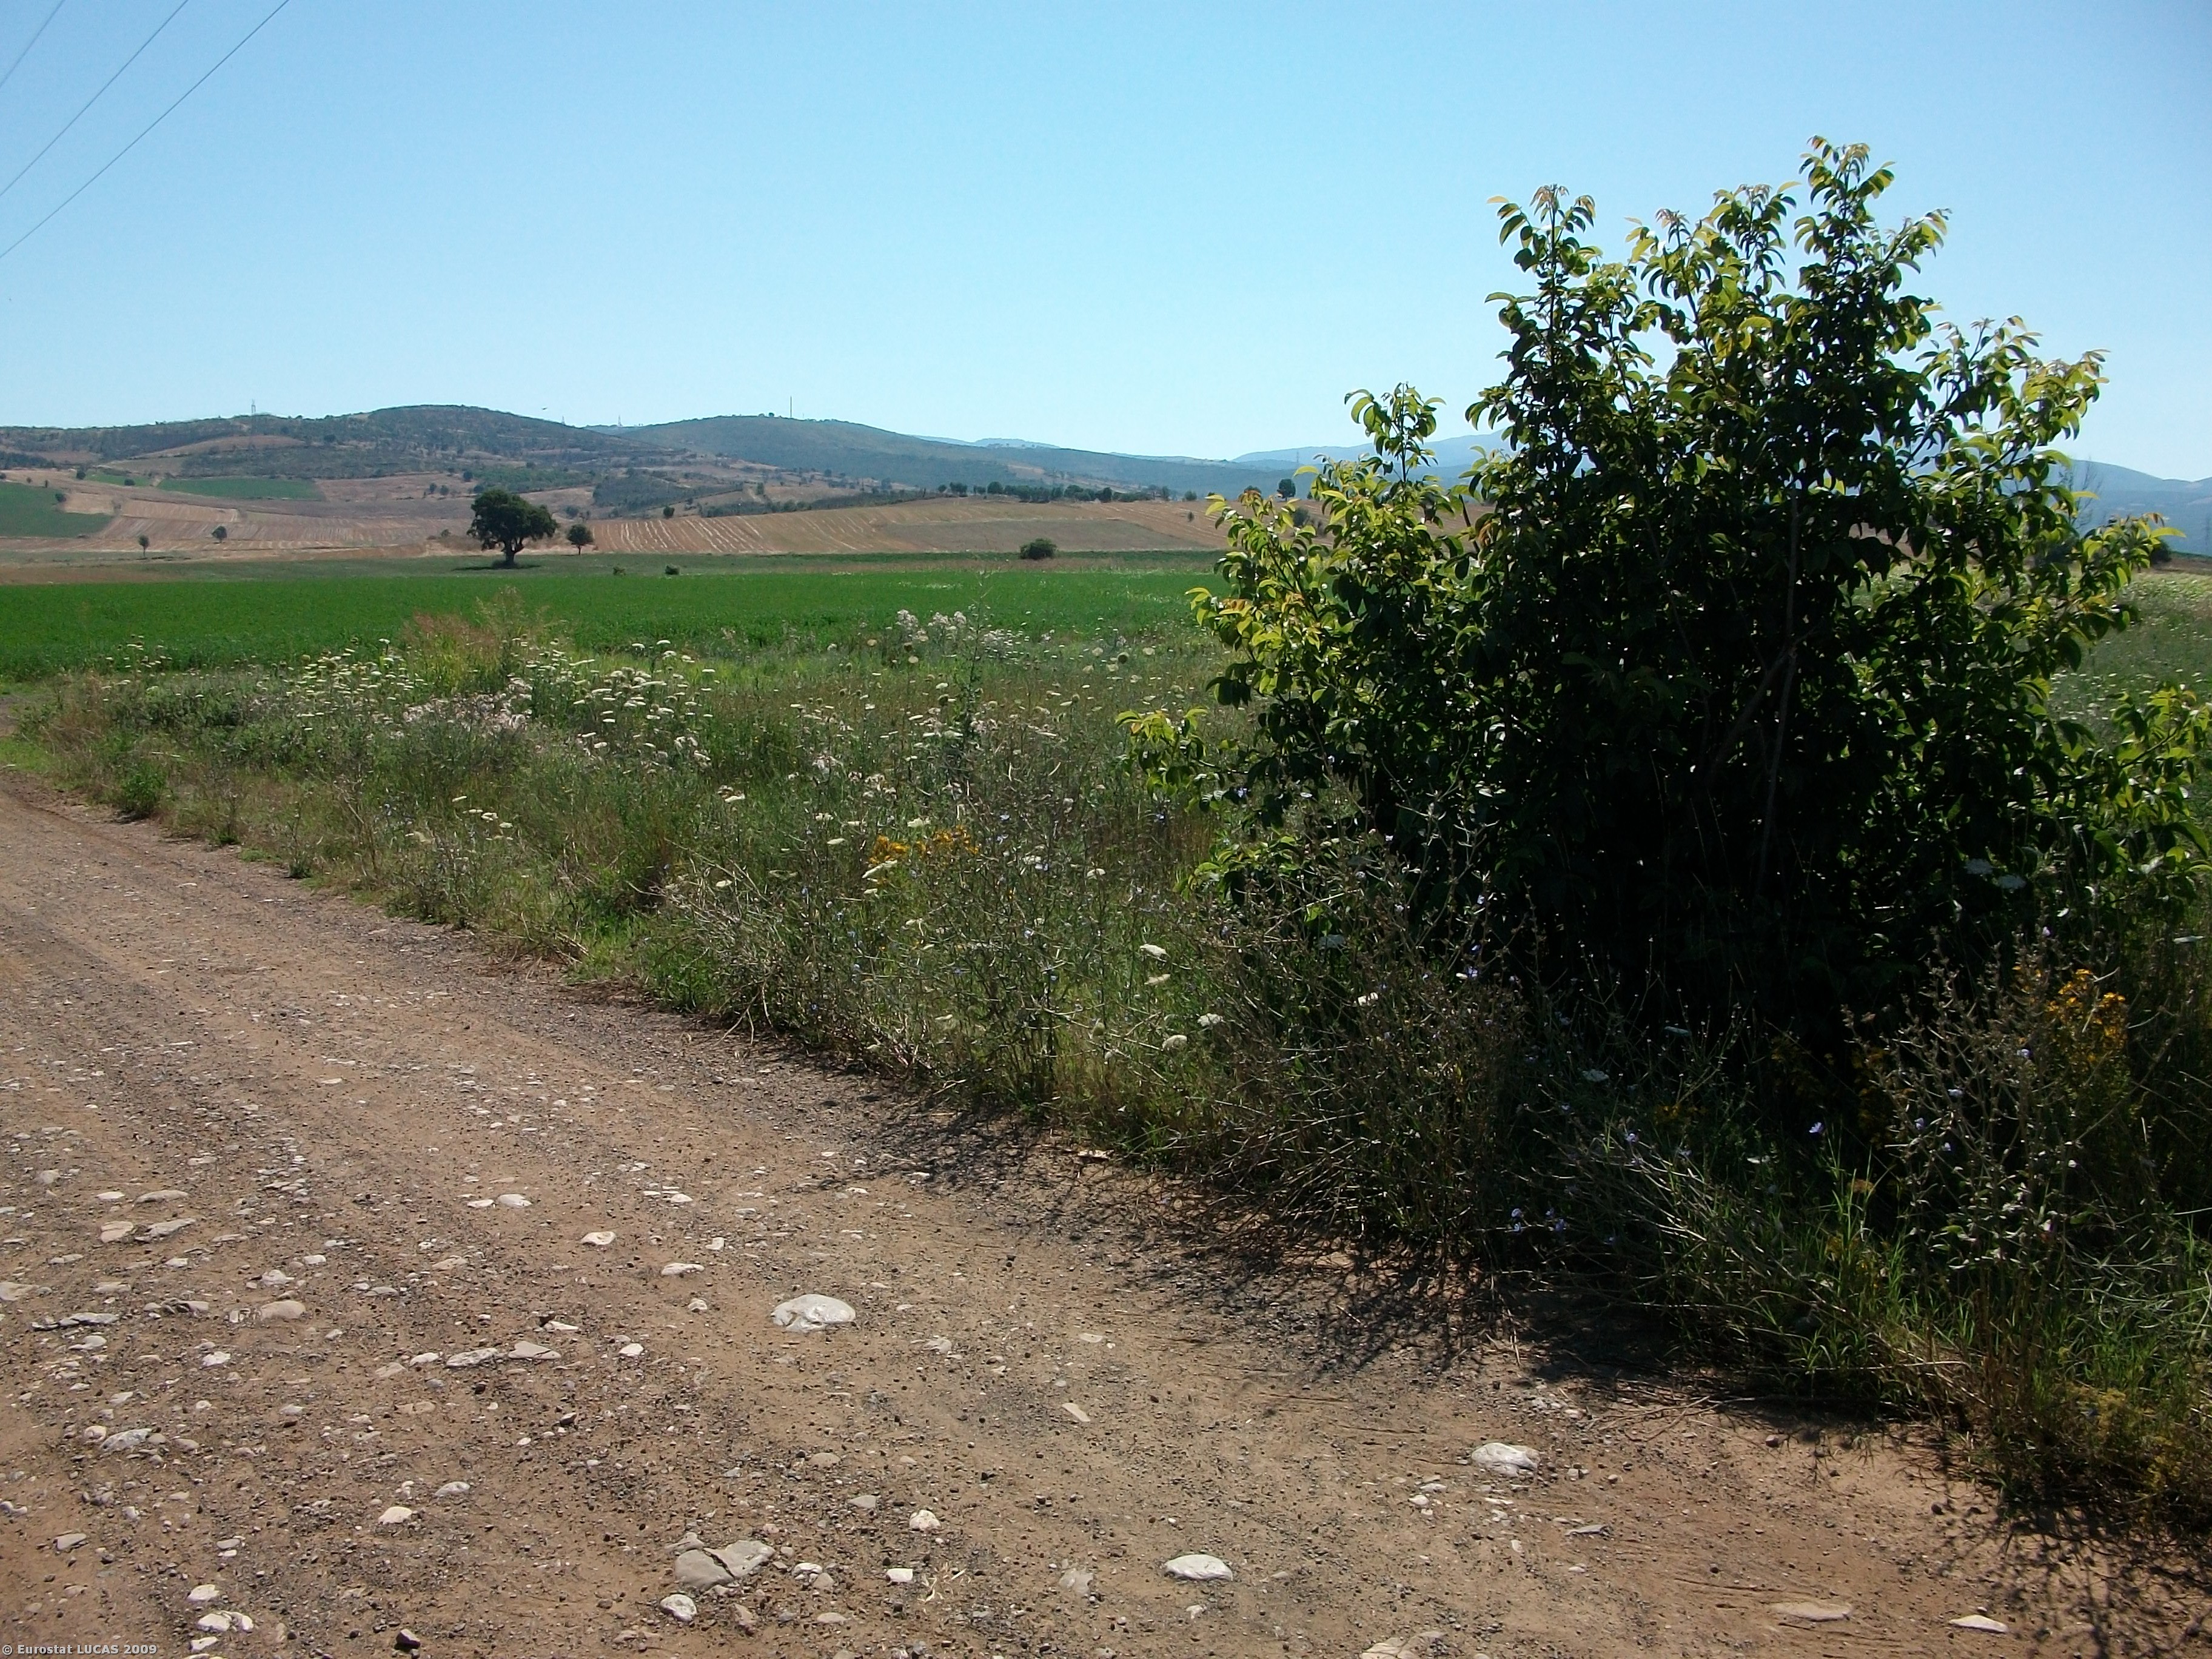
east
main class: Cropland
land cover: Maize
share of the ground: > 75 %
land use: Agriculture (excluding fallow land and kitchen gardens)
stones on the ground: < 10 %
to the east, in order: Maize; Shruby margins; Paved roads, cycling and walking lanes; Shruby margins; Electric lines; Clovers; Grass margins; Other fresh vegetables; Grass margins
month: July
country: GR
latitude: 39.0889
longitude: 22.4345
